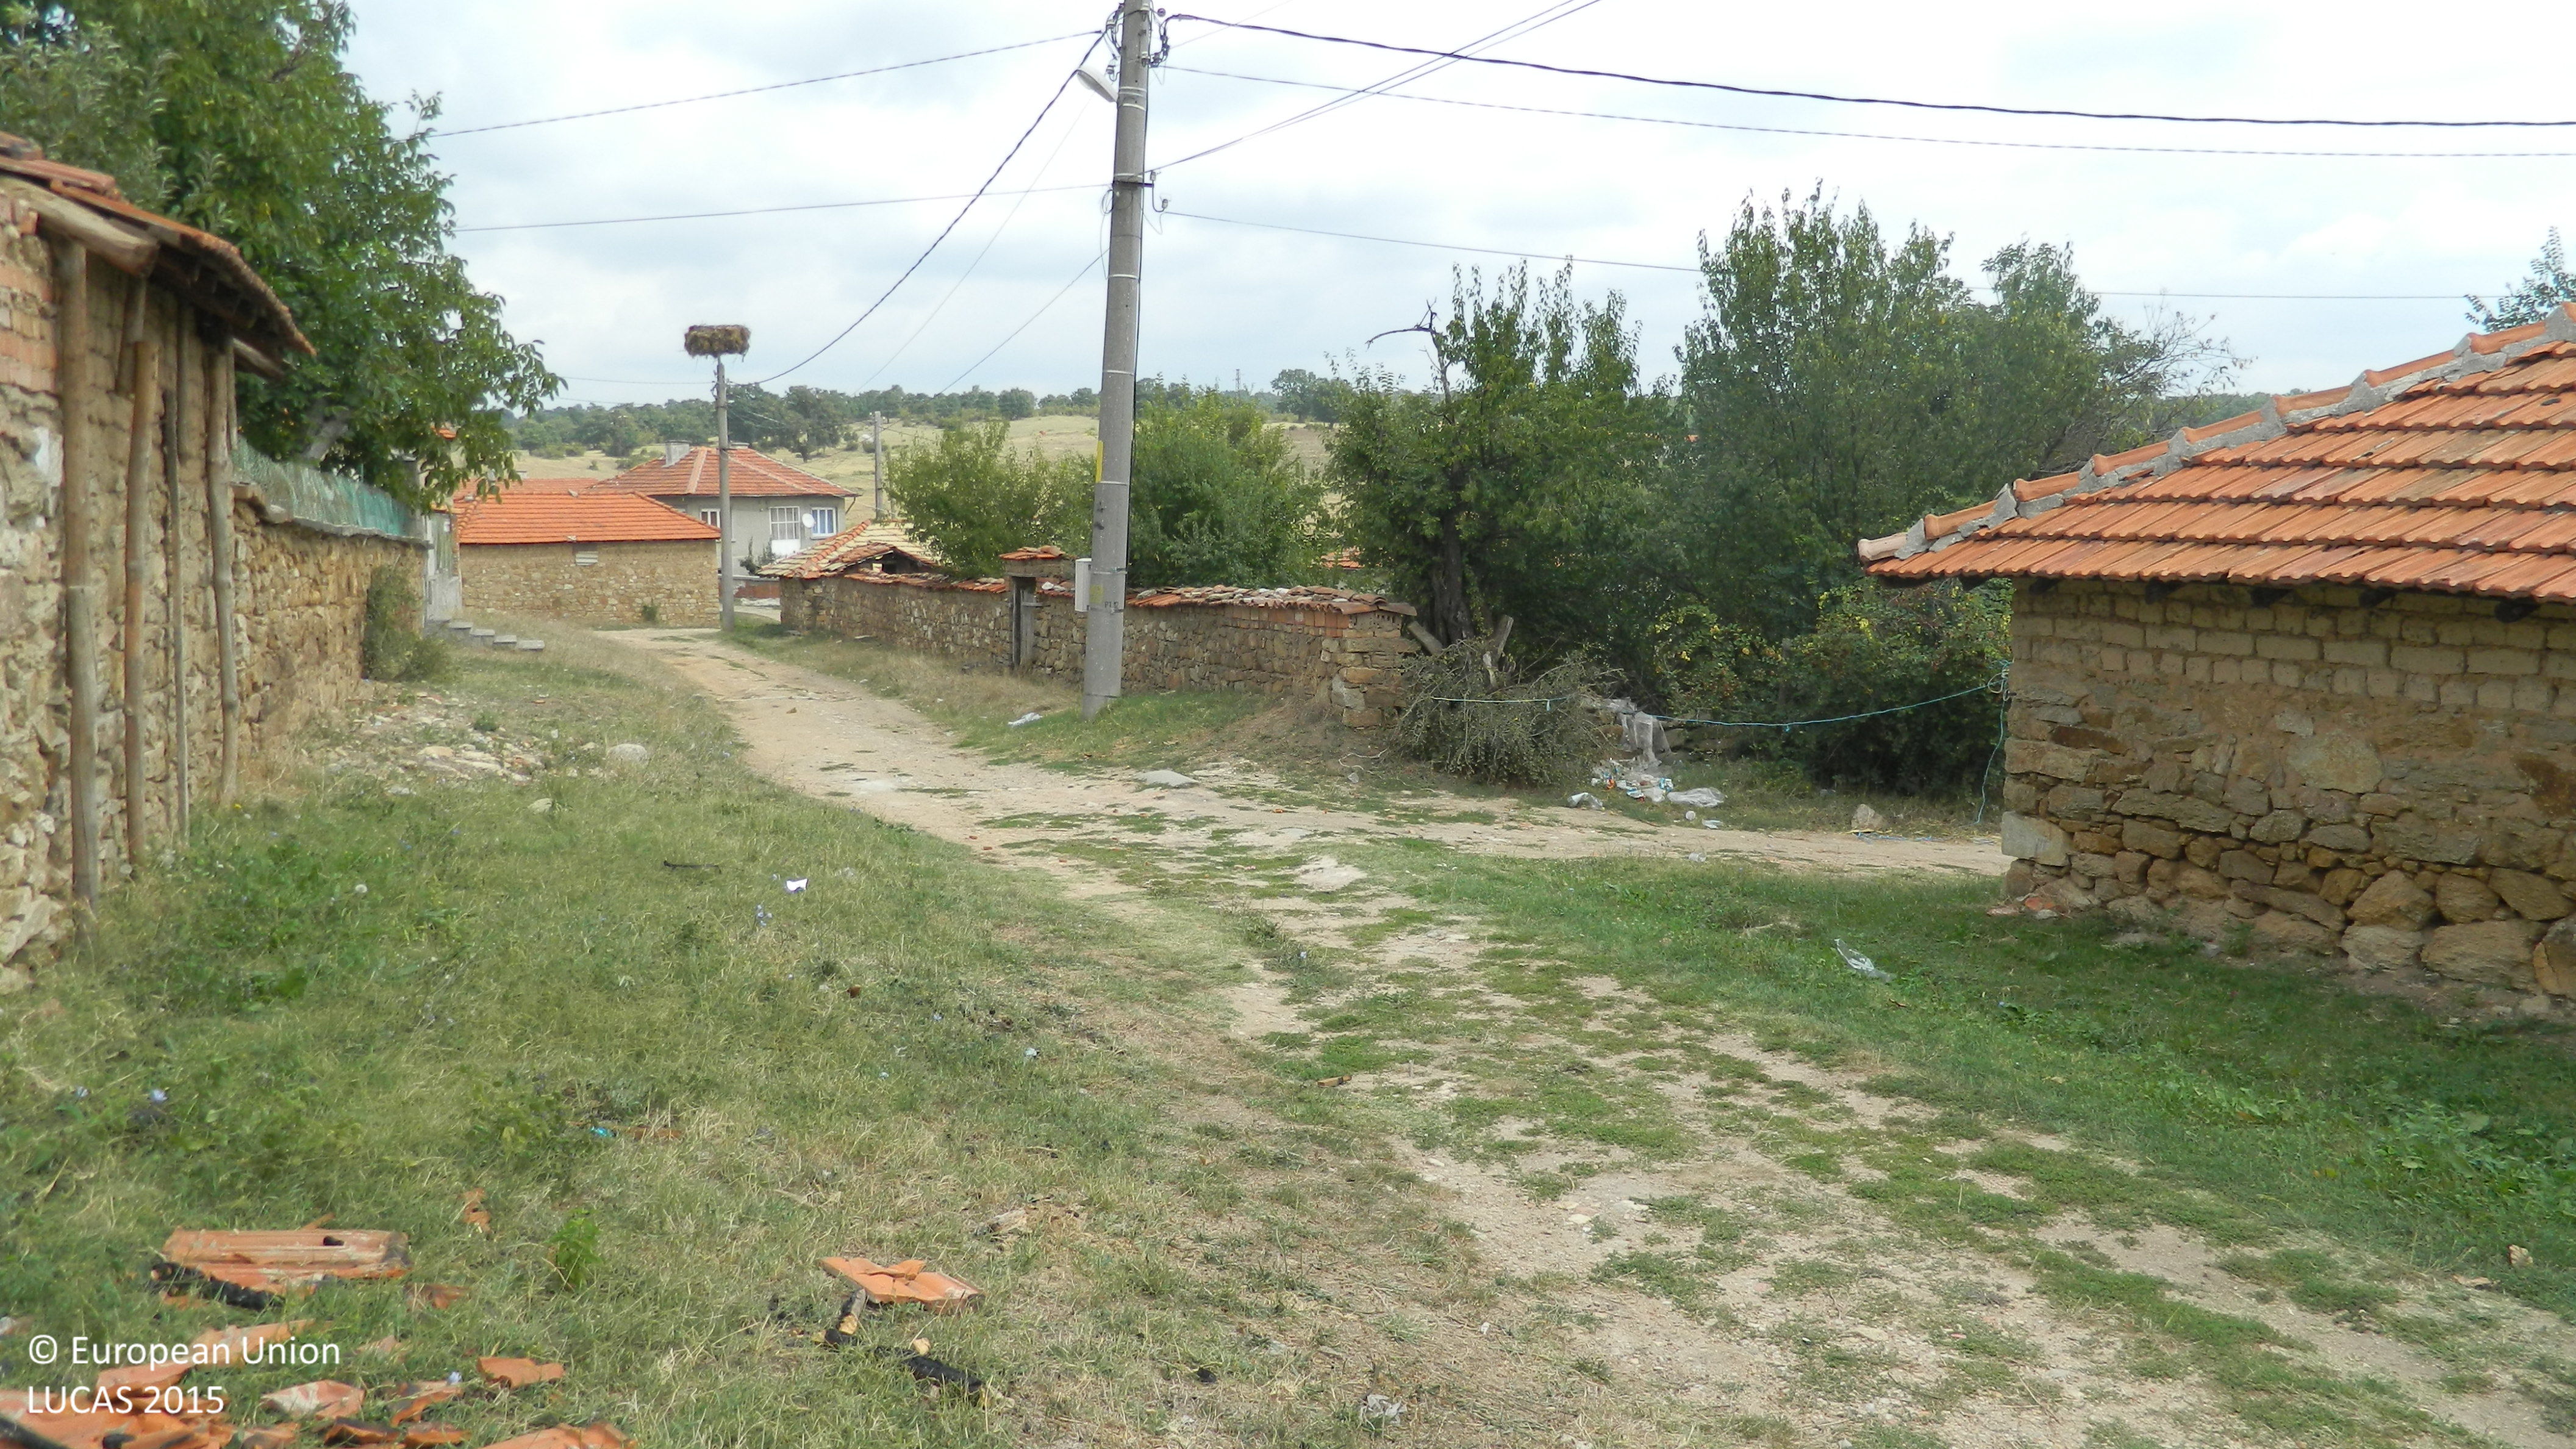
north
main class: Grassland
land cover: Grassland without tree/shrub cover
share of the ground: > 75 %
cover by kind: herbaceous plants 95 %, unconsolidated bare surface 5 %
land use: Residential
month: September
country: BG
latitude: 41.8416
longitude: 25.7100
